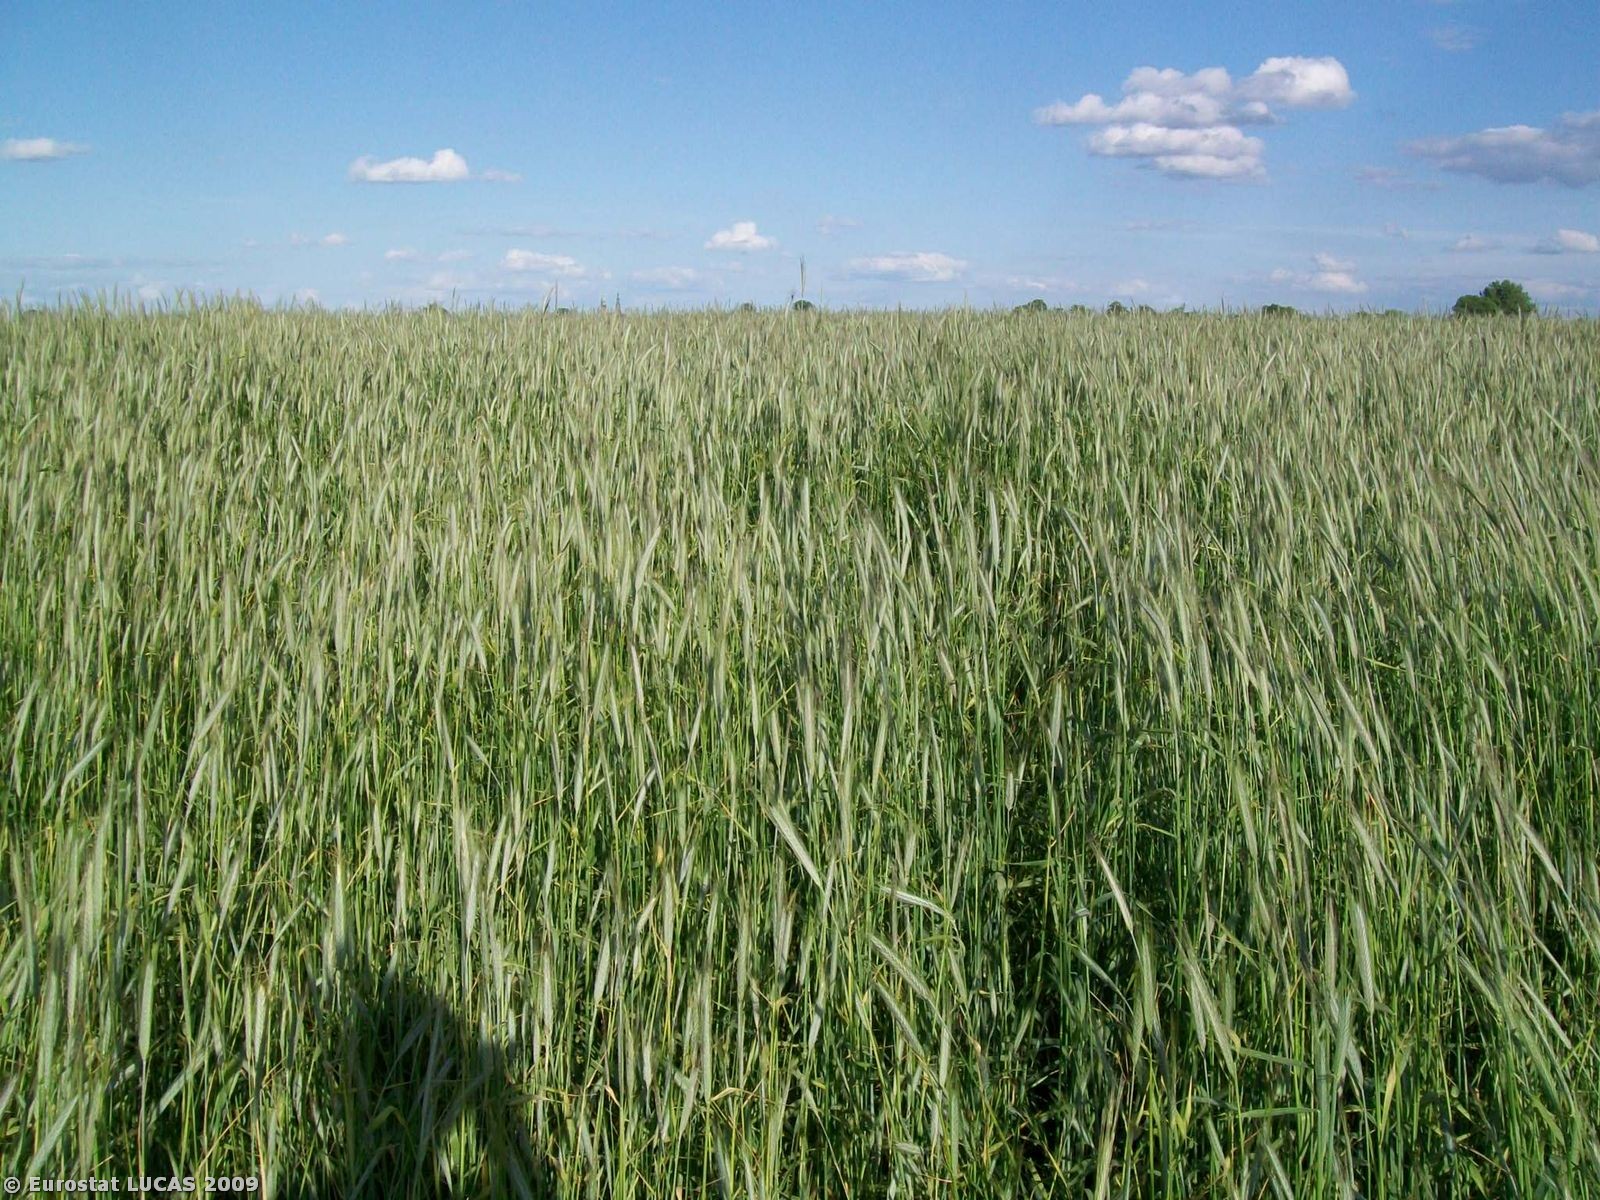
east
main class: Cropland
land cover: Rye
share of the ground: > 75 %
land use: Agriculture (excluding fallow land and kitchen gardens)
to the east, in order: Rye; Tracks; Grassland without tree/shrub cover
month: May
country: PL
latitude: 52.0141
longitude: 16.2574
